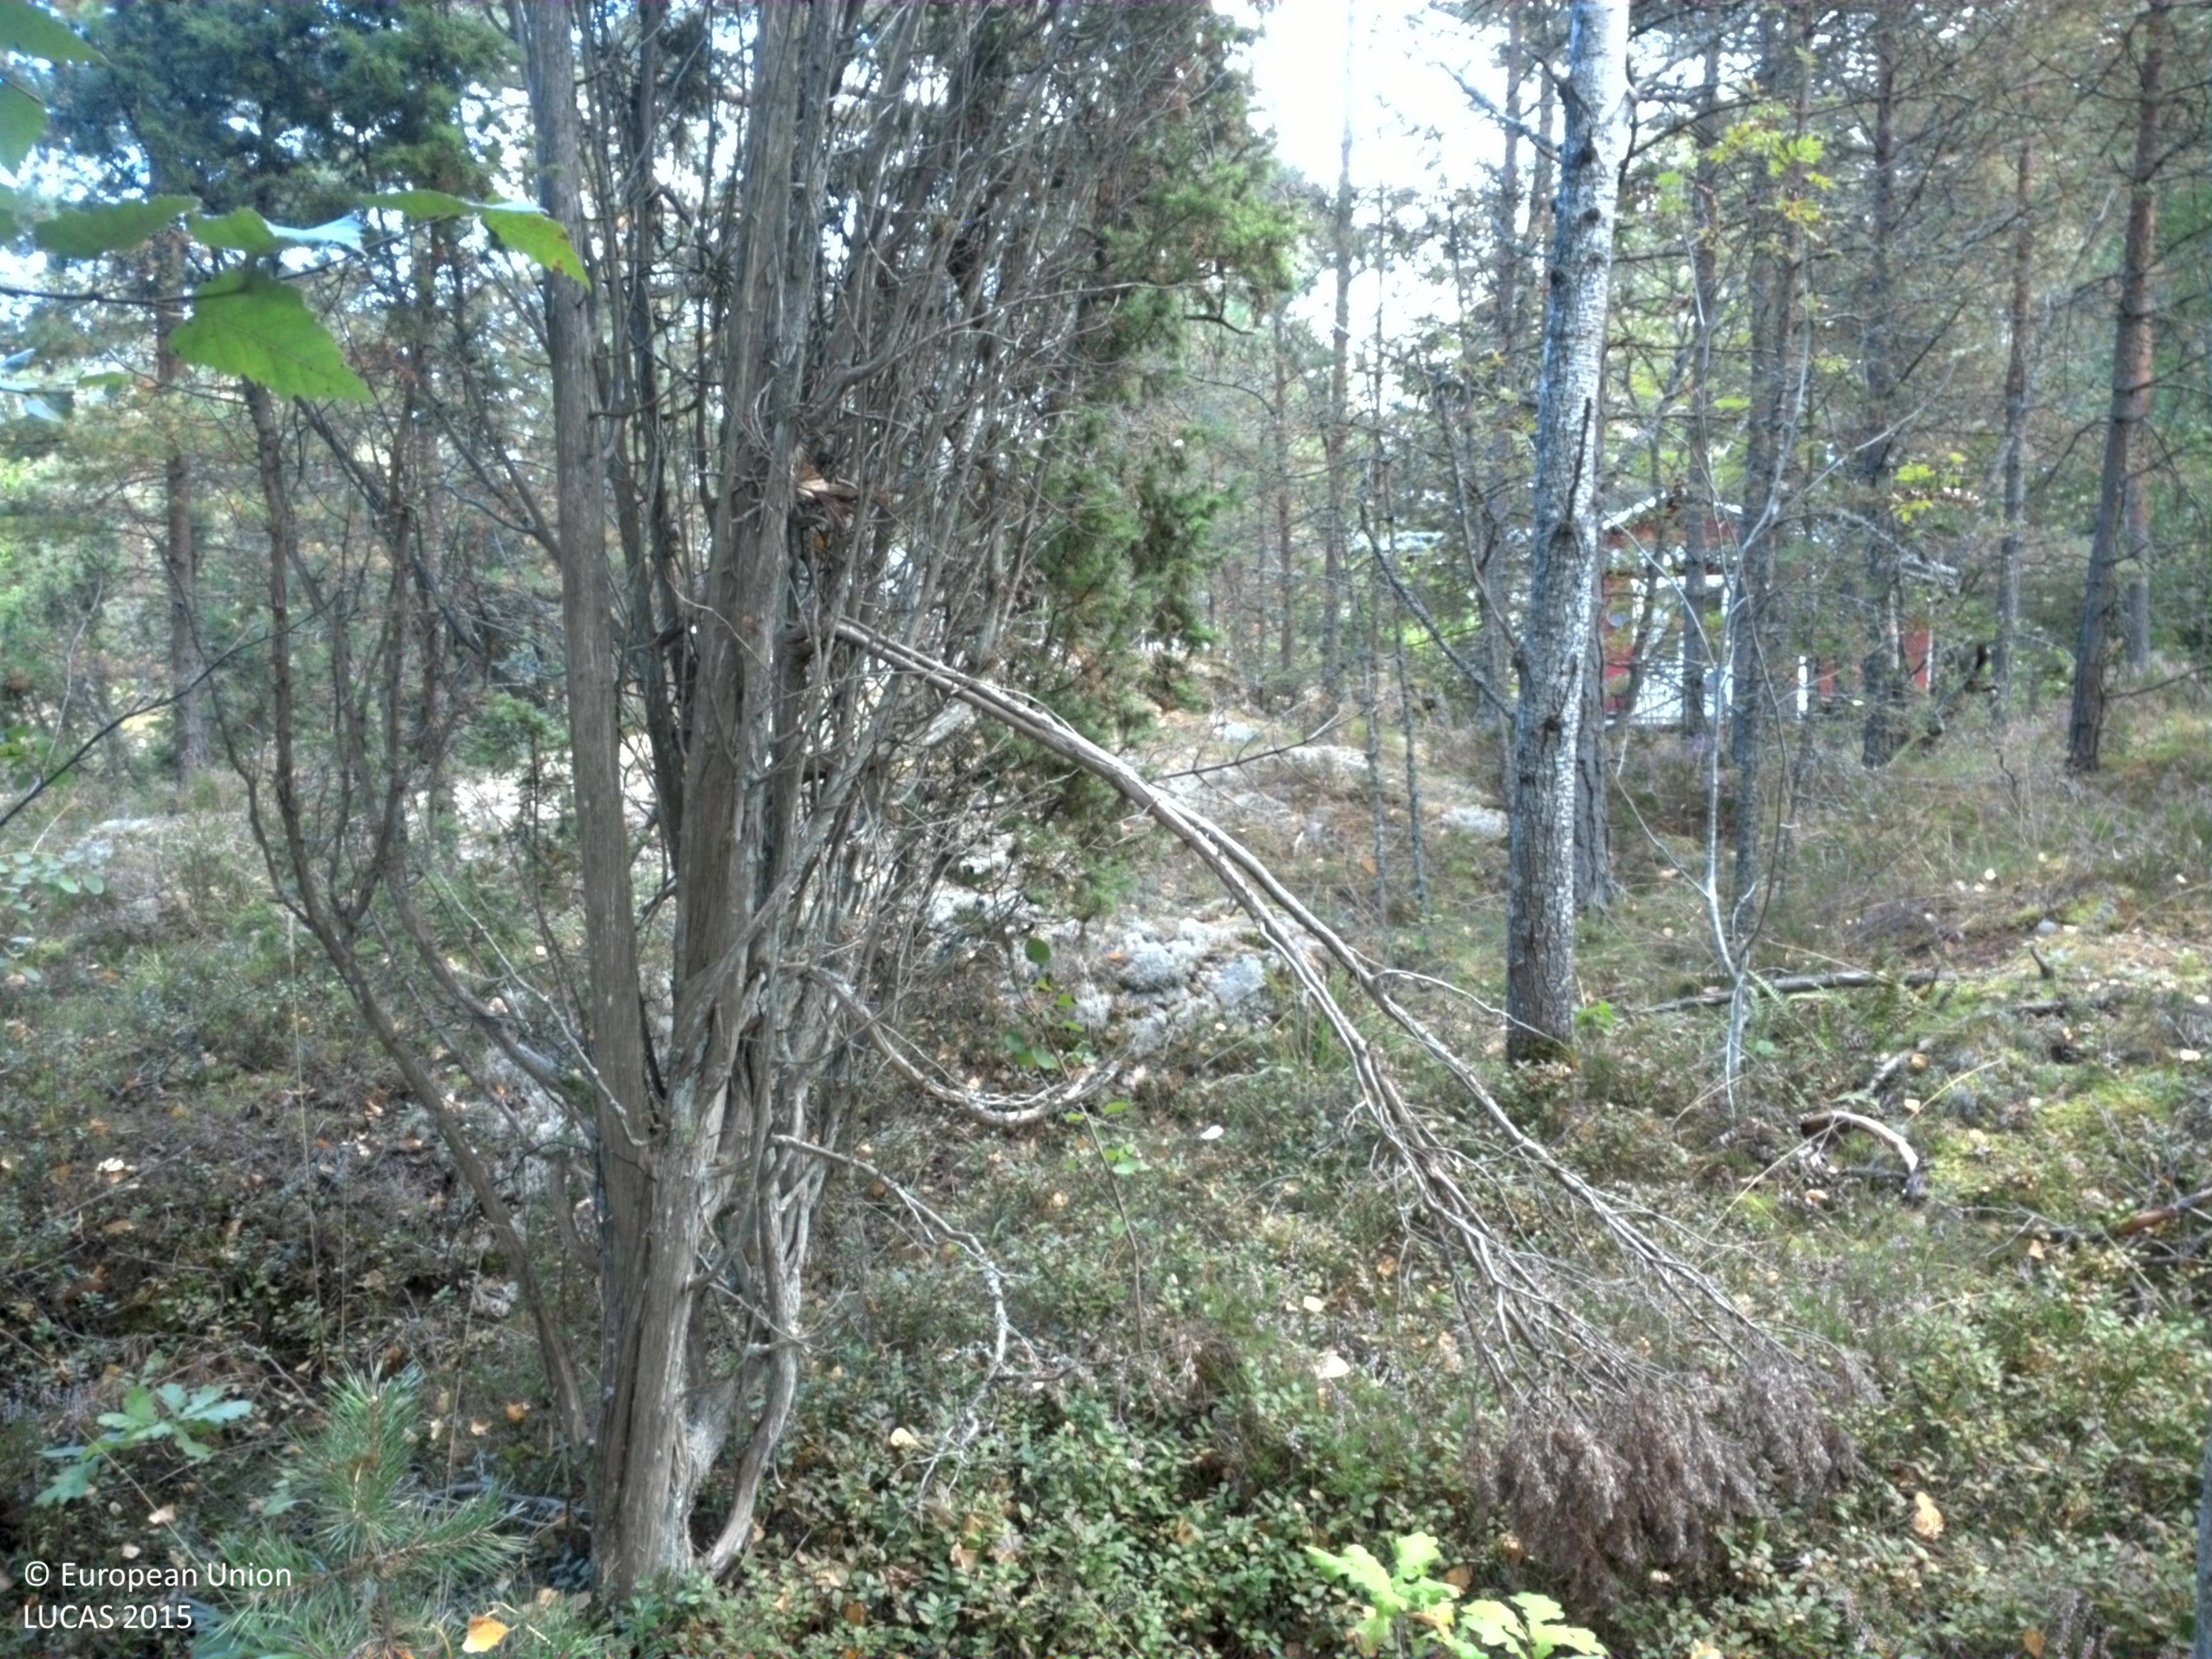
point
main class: Woodland
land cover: Pine dominated coniferous woodland
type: boreal forest
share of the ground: 50 - 75 %
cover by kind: coniferous forest trees 55 %, lichens and mosses 20 %, shrubs 15 %, broadleaved forest trees 10 %
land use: Amenities, museums, leisure
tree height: > 5 m
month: September
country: SE
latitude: 59.3538
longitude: 18.6375
